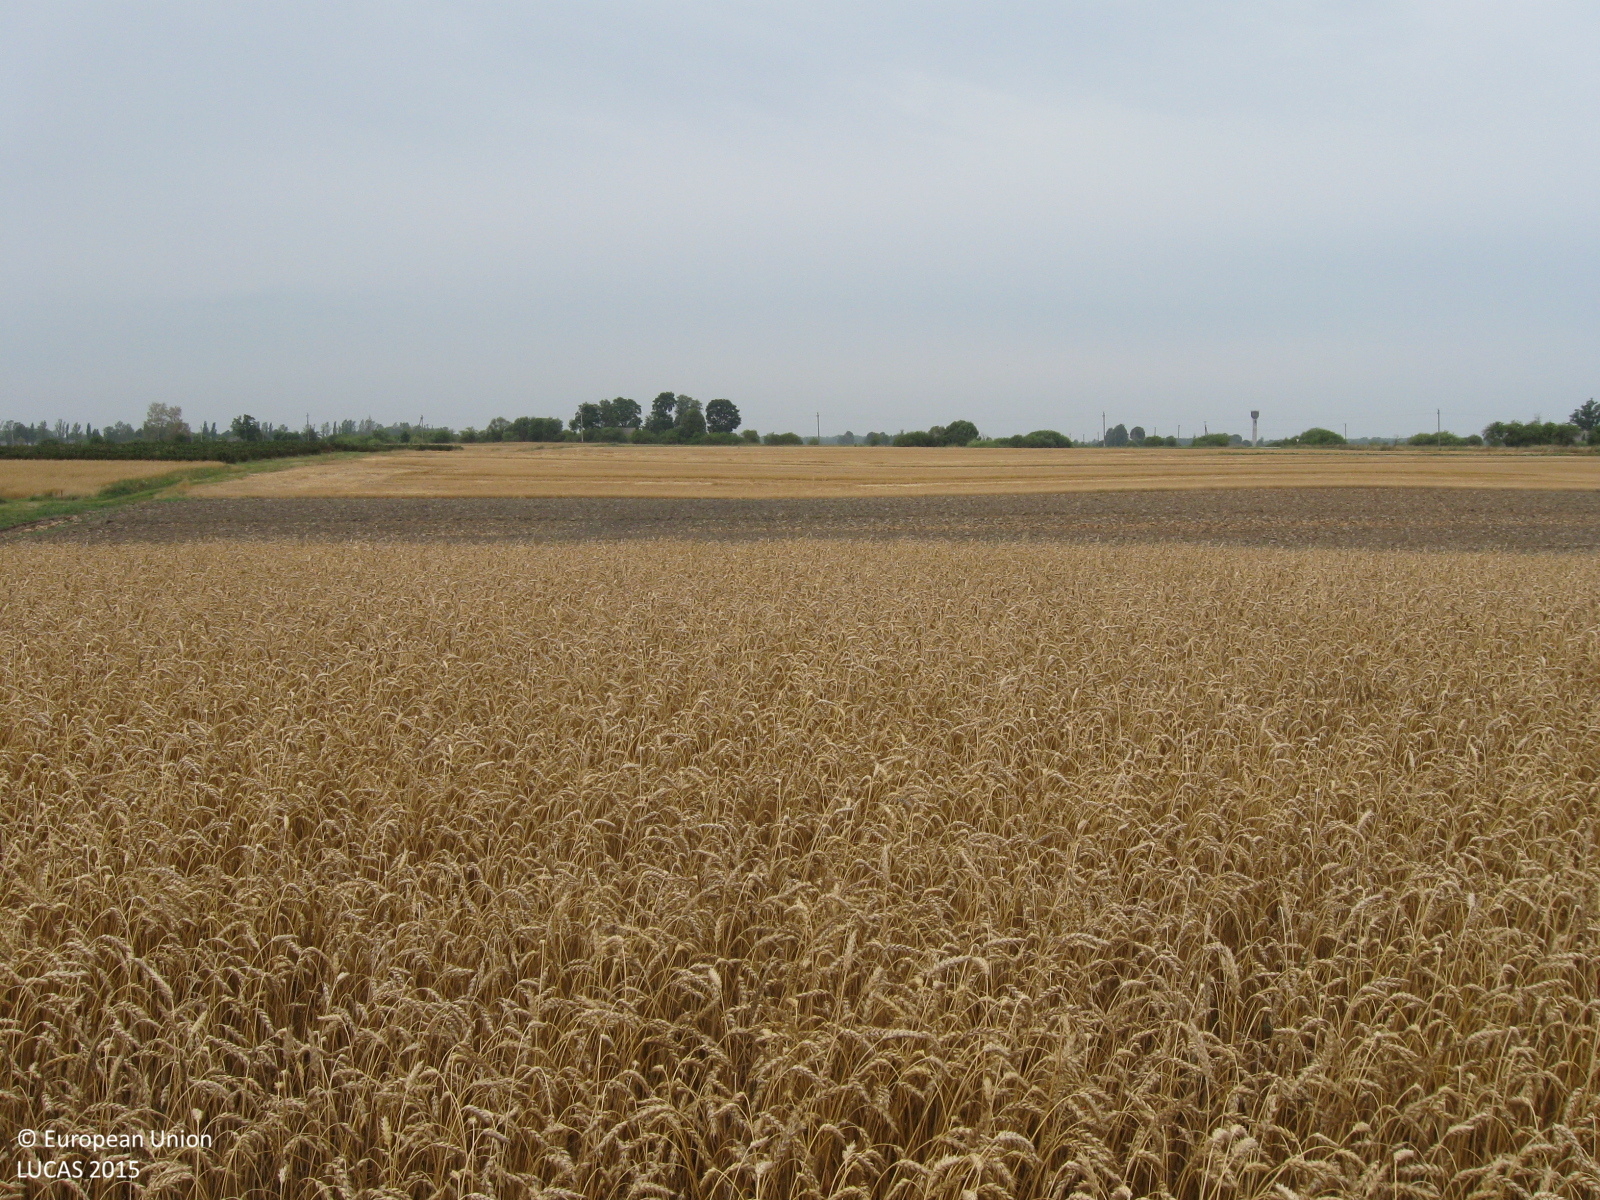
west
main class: Cropland
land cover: Common wheat
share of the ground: > 75 %
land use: Agriculture (excluding fallow land and kitchen gardens)
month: August
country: LT
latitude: 55.1168
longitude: 23.3893
